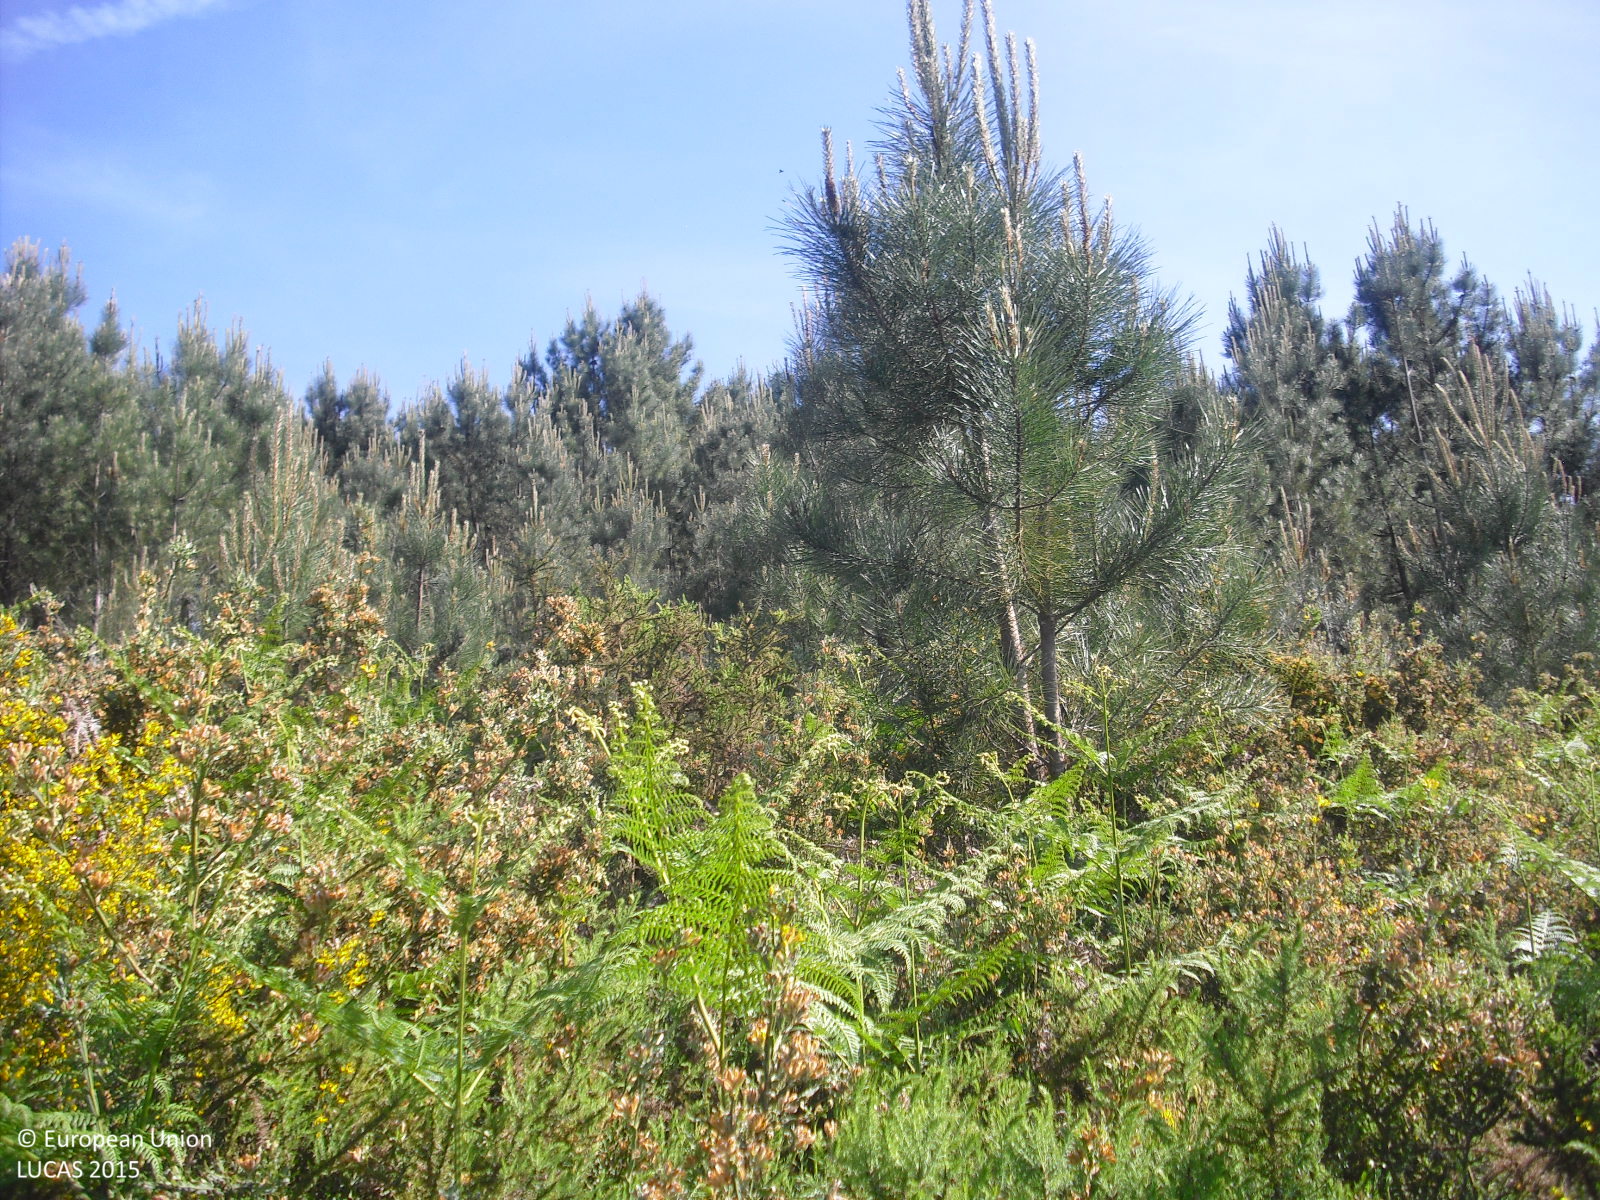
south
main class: Shrubland
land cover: Shrubland with sparse tree cover
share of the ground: > 75 %
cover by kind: shrubs 95 %, coniferous forest trees 5 %
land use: Forestry
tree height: < 5 m
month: May
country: ES
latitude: 41.8897
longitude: -8.1199
